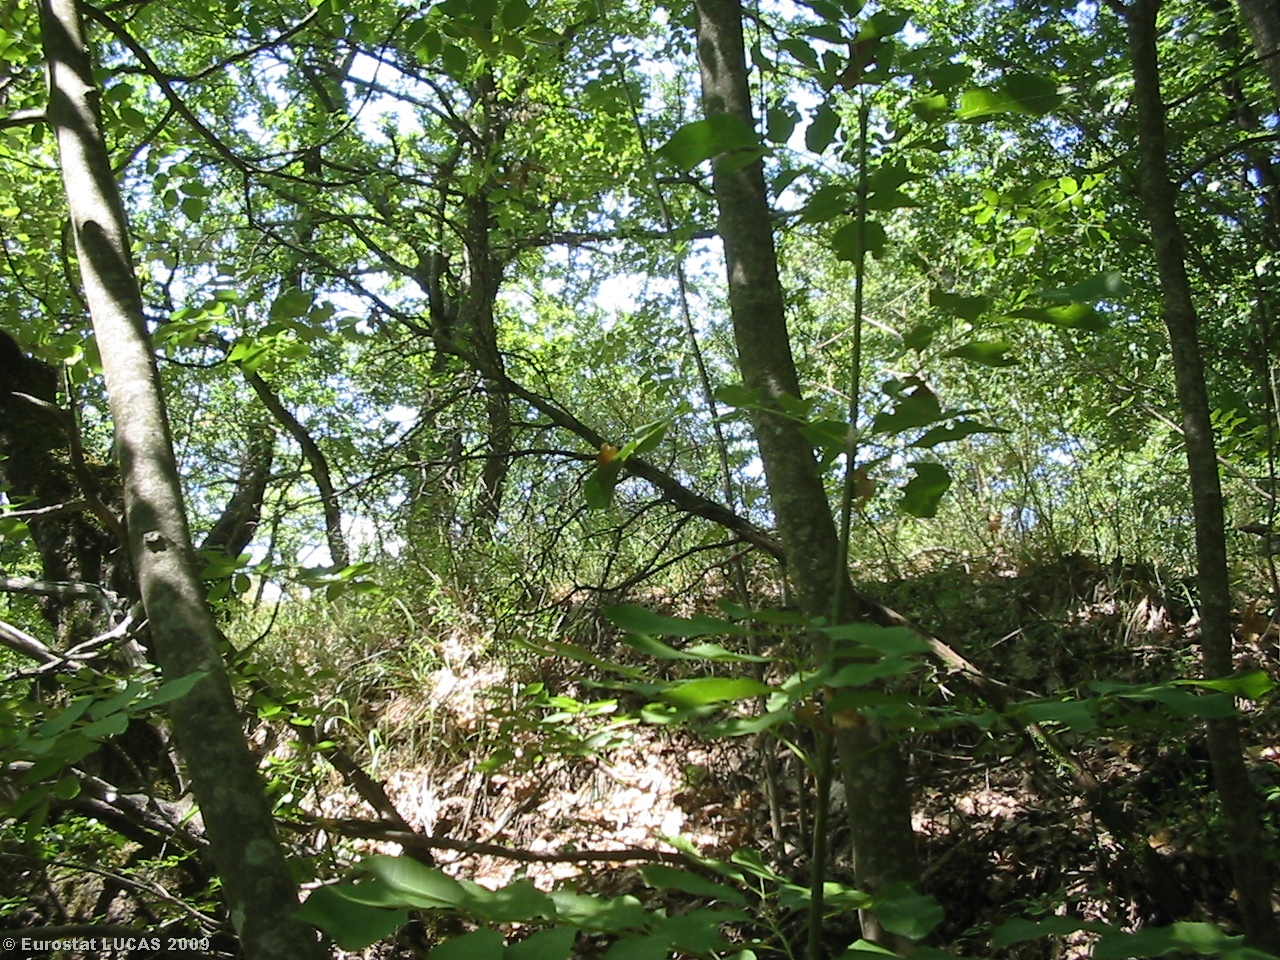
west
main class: Woodland
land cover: Broadleaved woodland
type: thermophilous deciduous forest
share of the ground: > 75 %
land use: Forestry
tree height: > 5 m
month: August
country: IT
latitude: 44.4405
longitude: 10.2382
